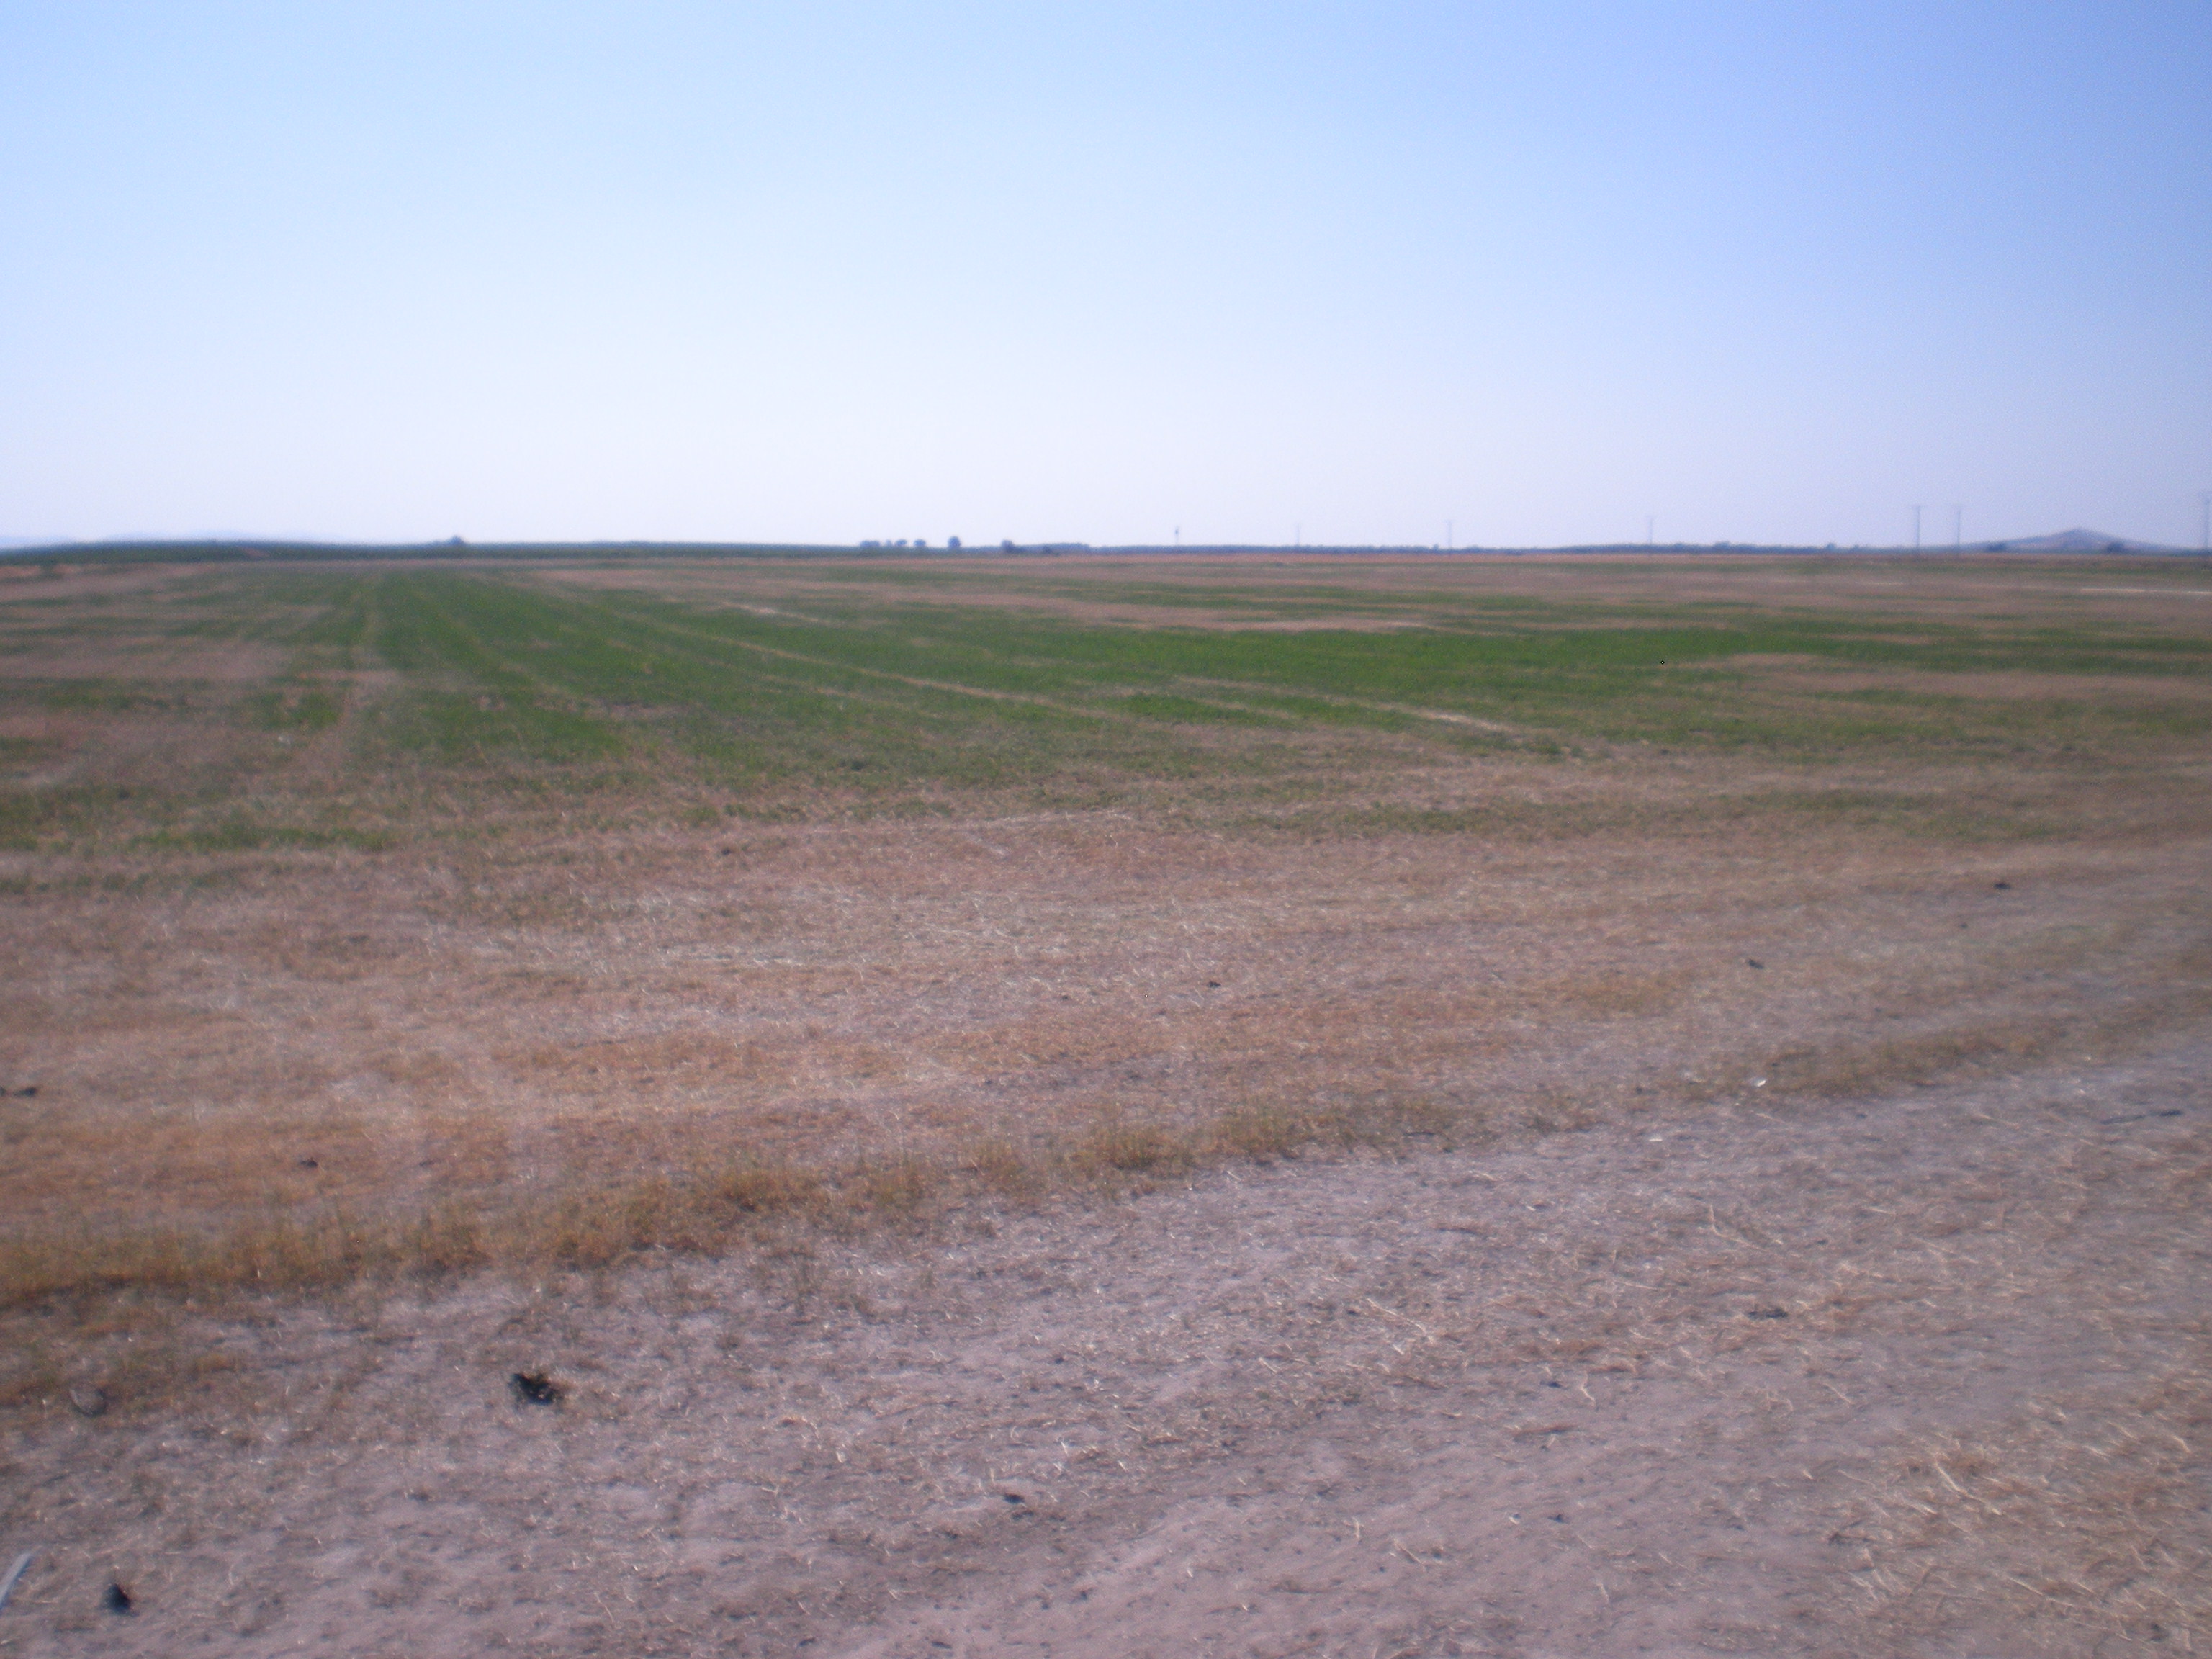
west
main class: Cropland
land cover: Barley
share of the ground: < 10 %
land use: Agriculture (excluding fallow land and kitchen gardens)
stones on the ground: < 10 %
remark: Harvested field
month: July
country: ES
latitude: 39.3103
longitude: -3.1093
